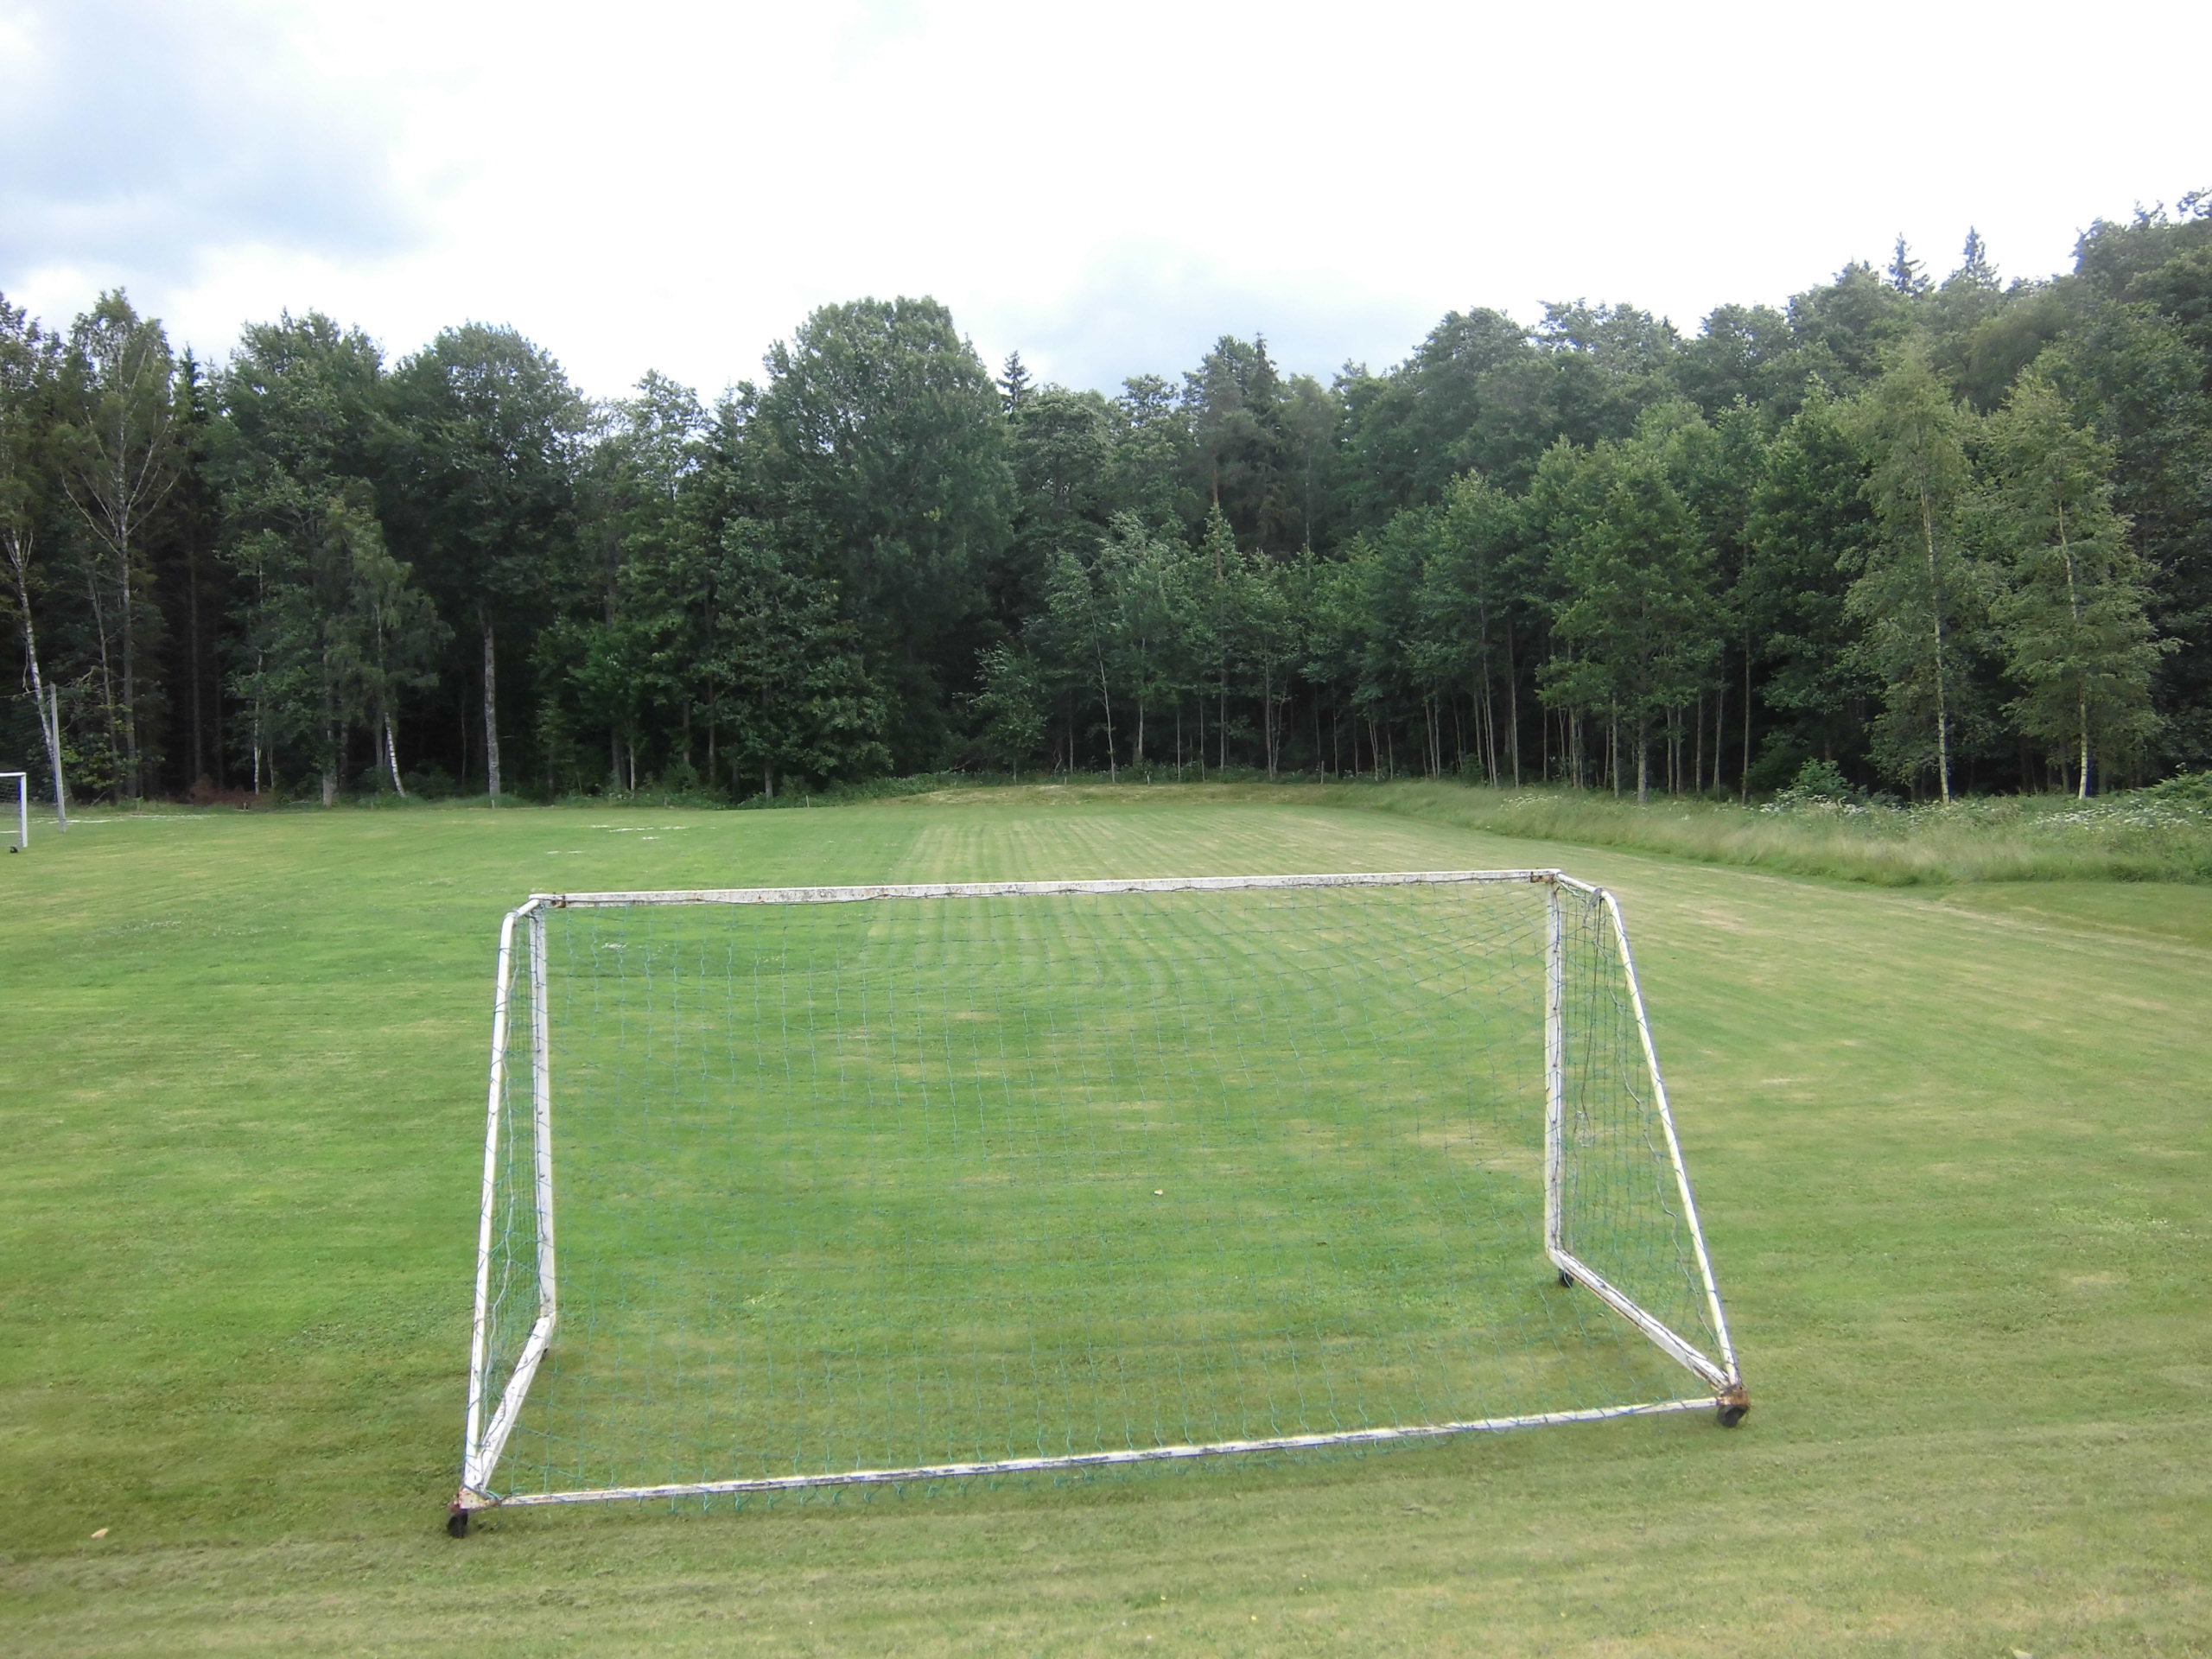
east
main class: Grassland
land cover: Grassland with sparse tree/shrub cover
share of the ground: > 75 %
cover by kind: herbaceous plants 95 %, coniferous forest trees 5 %
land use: Sport
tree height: < 5 m
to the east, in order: Grassland with sparse tree/shrub cover; Fences; Broadleaved woodland; Spruce dominated mixed woodland; Spruce dominated coniferous woodland
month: July
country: SE
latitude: 57.3107
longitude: 15.1265
